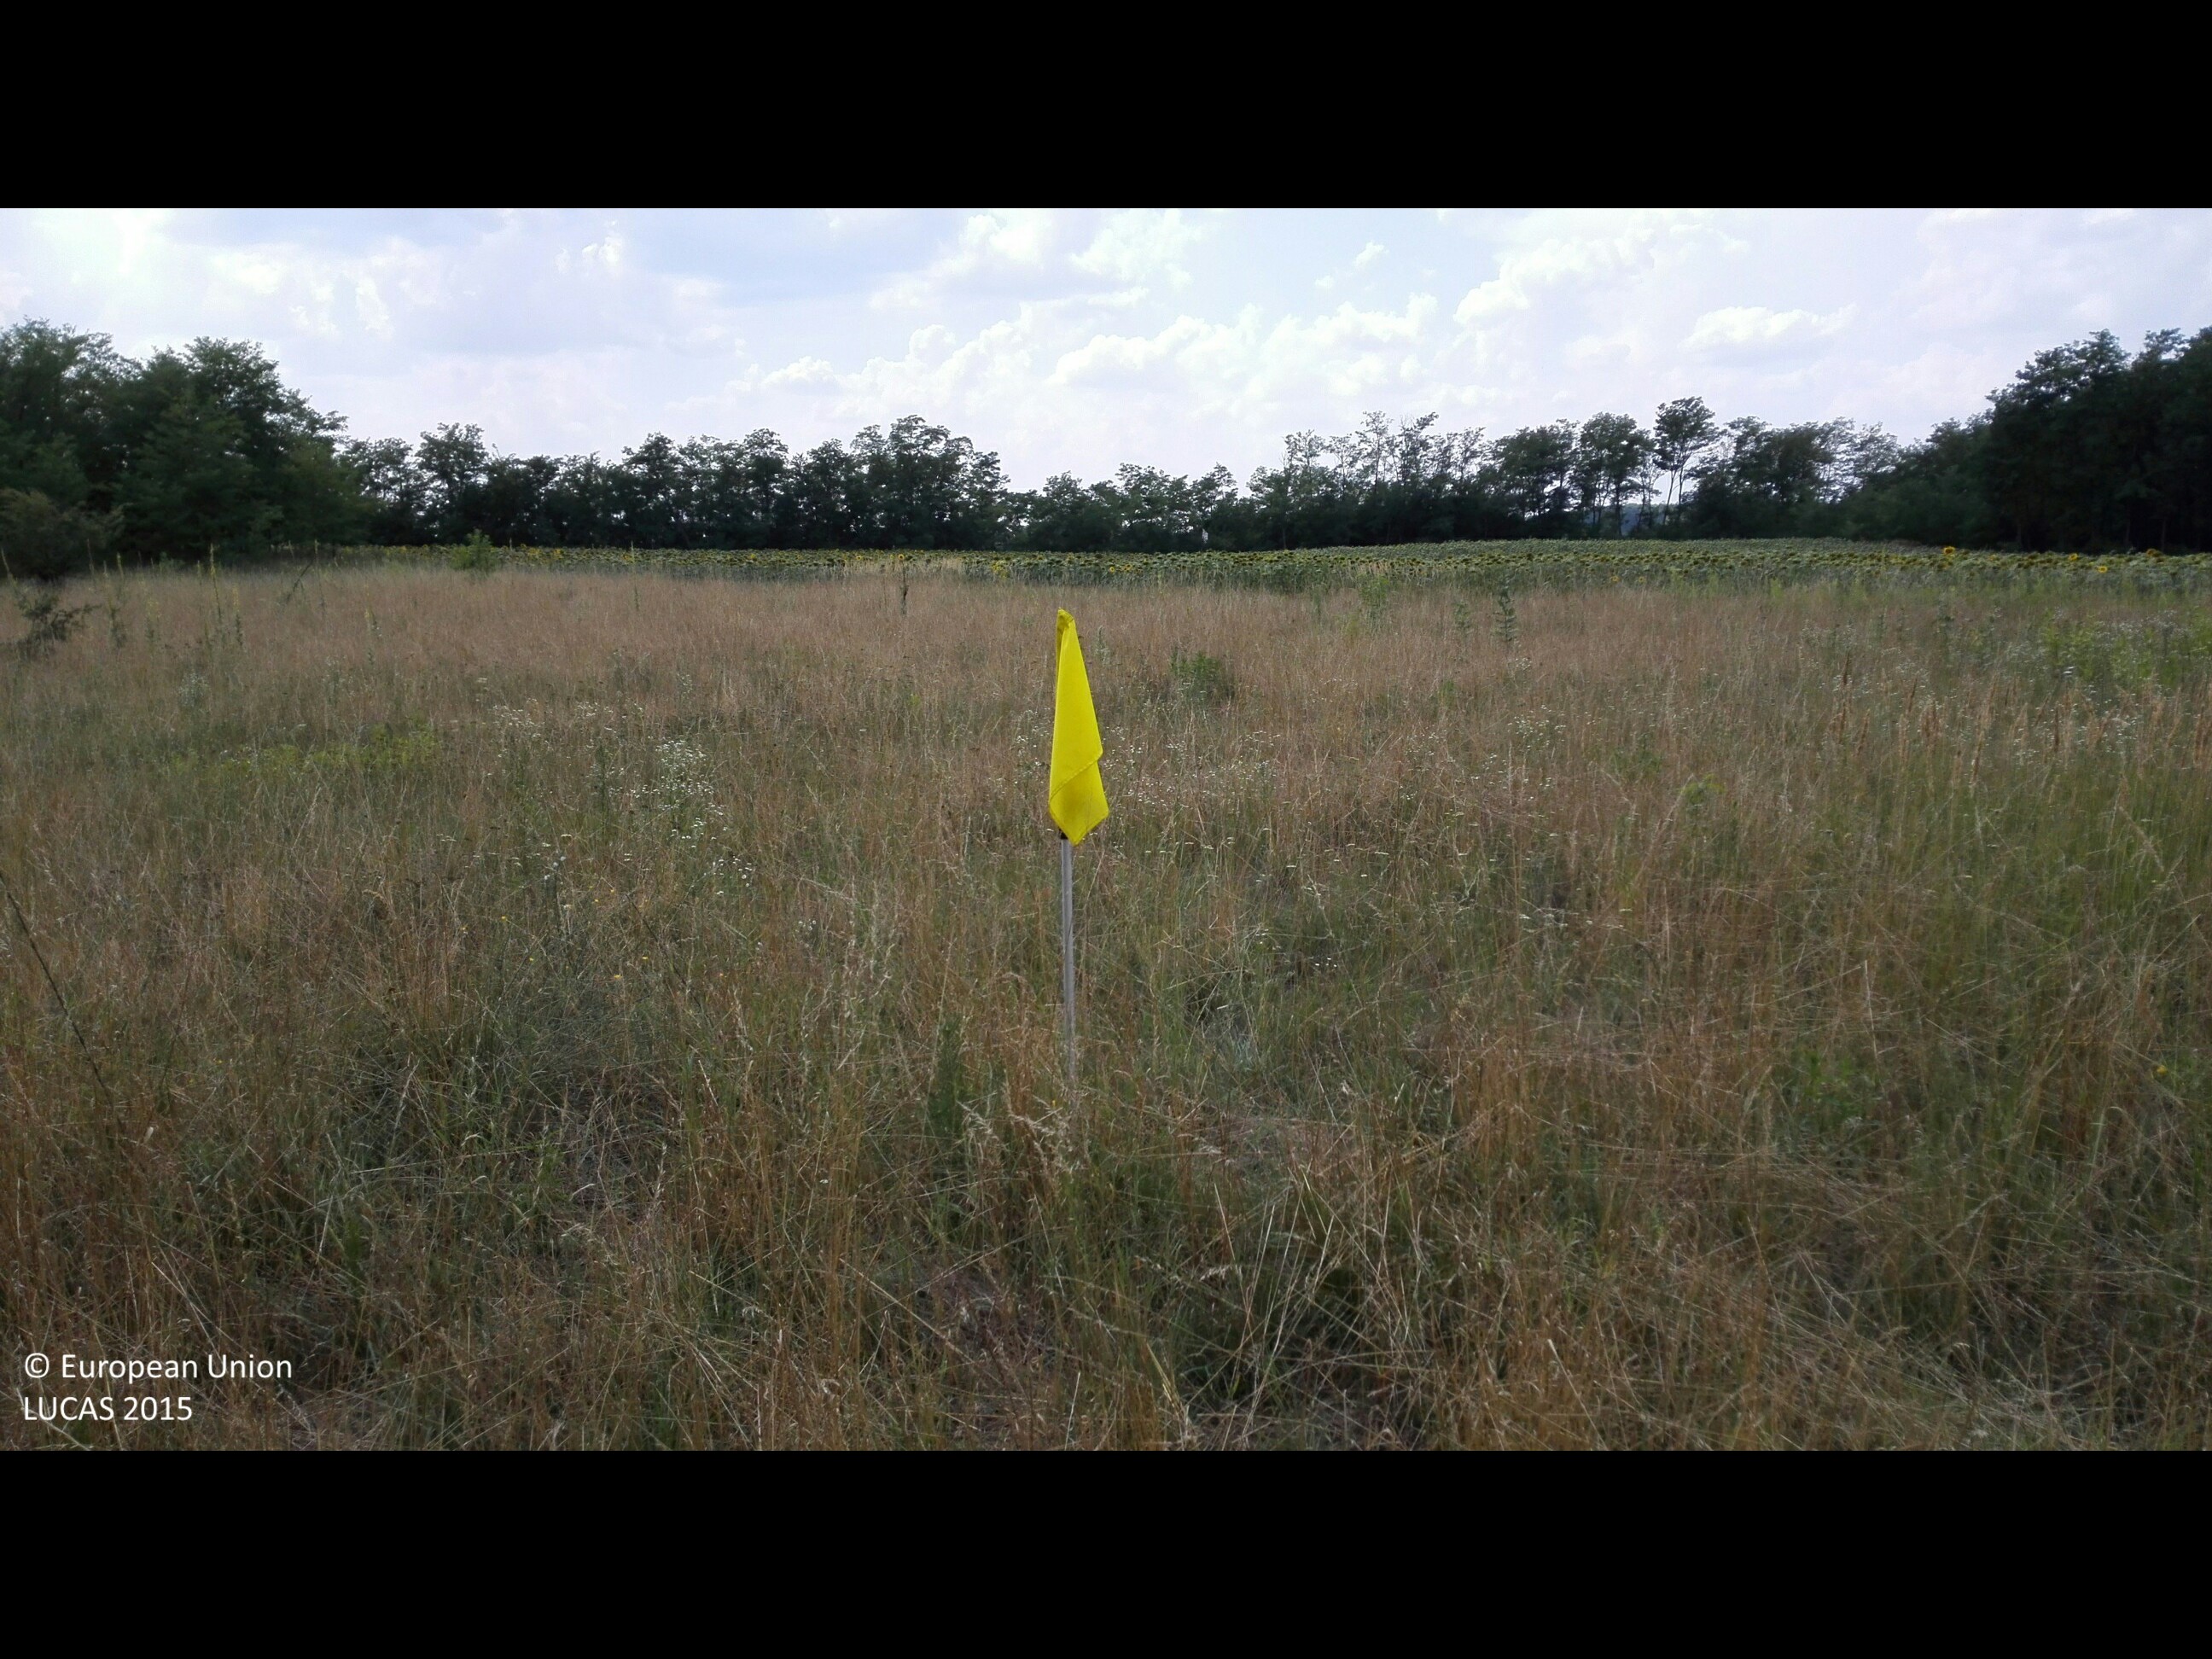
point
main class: Grassland
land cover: Grassland with sparse tree/shrub cover
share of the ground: > 75 %
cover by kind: herbaceous plants 85 %, shrubs 10 %, broadleaved forest trees 5 %
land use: Semi-natural and natural areas not in use
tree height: > 5 m
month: August
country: HU
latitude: 47.7011
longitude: 21.9230
